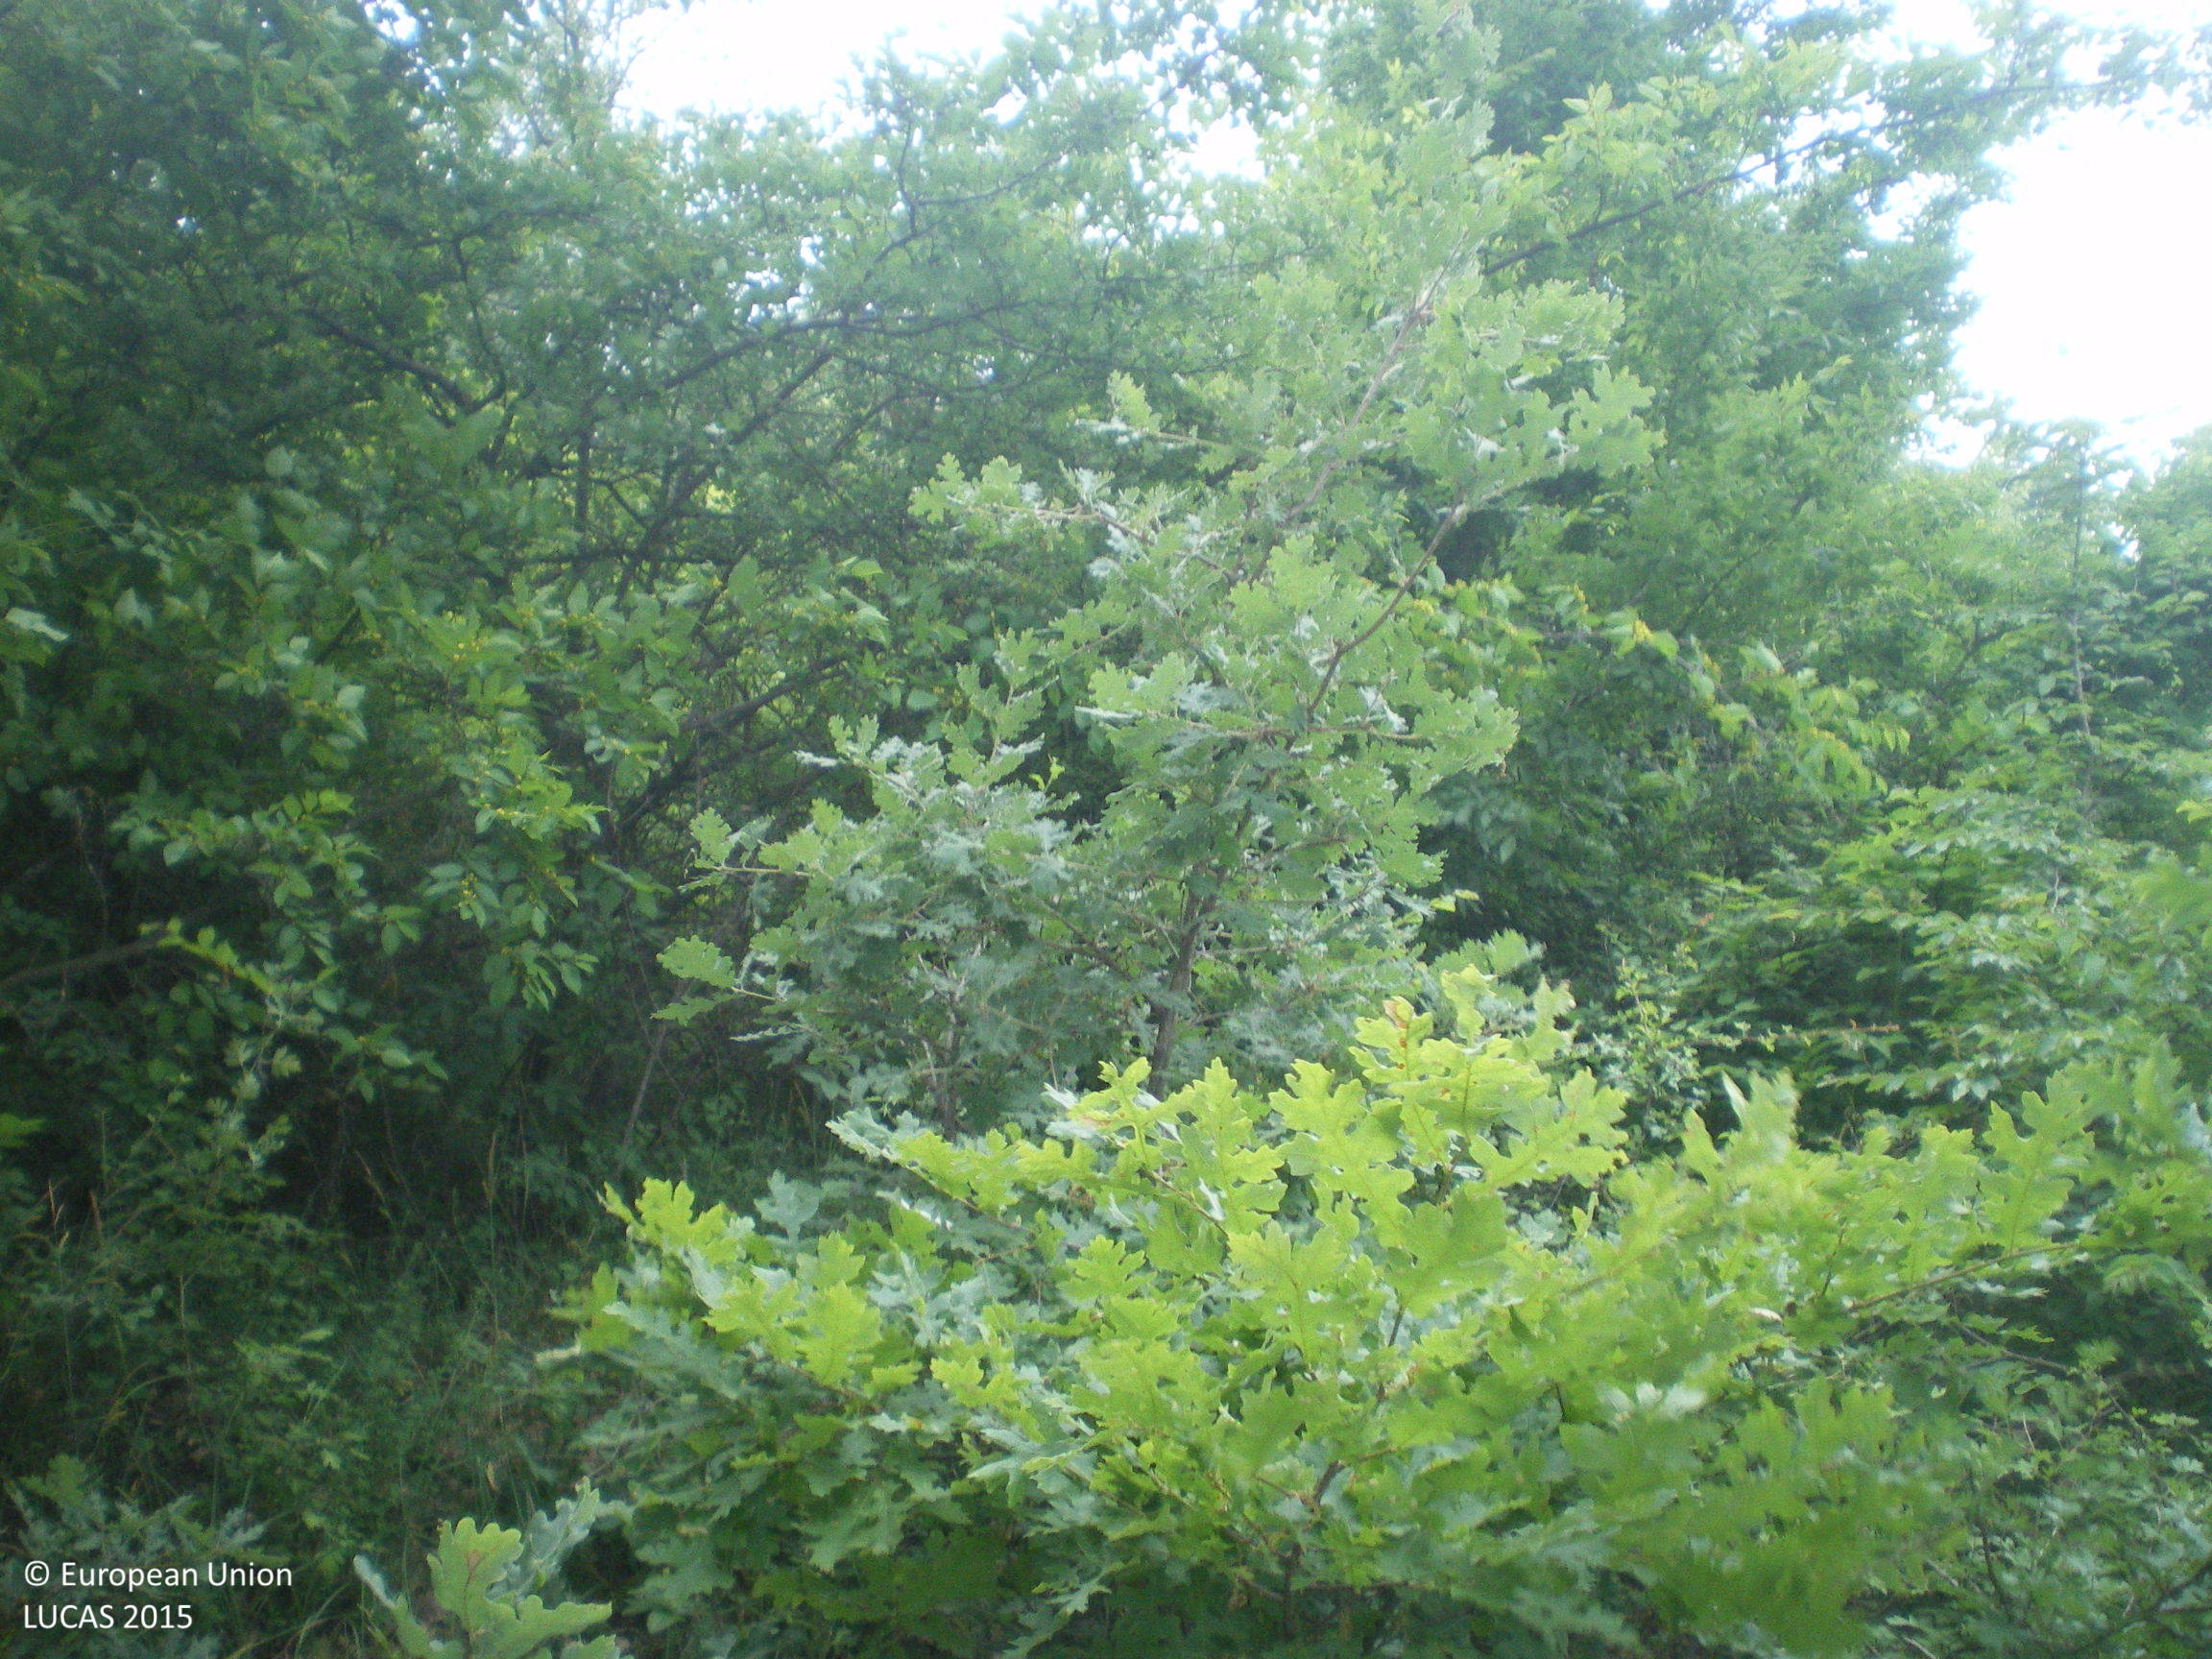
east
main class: Woodland
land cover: Broadleaved woodland
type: mesophytic deciduous forest
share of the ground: > 75 %
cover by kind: broadleaved forest trees 70 %, shrubs 20 %, herbaceous plants 10 %
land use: Forestry
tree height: > 5 m
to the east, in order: Broadleaved woodland
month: May
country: BG
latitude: 42.2786
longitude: 25.3800
